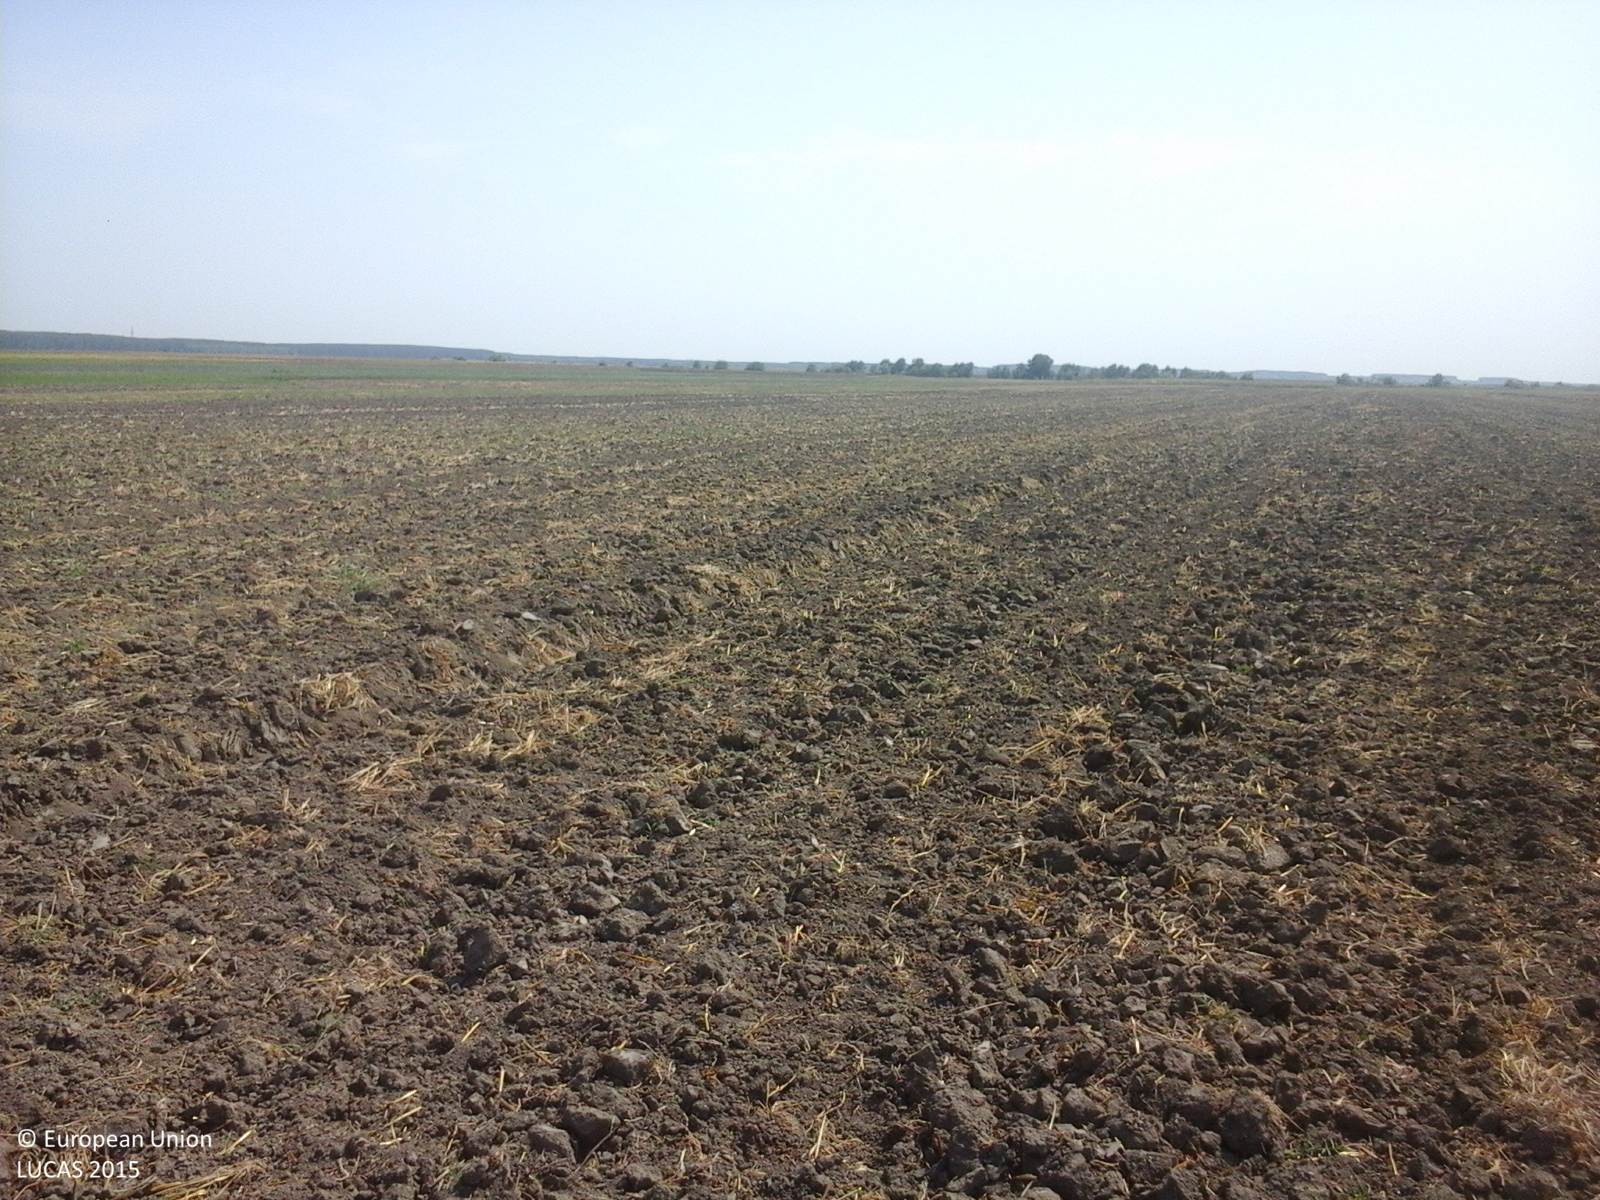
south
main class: Cropland
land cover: Durum wheat
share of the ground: < 10 %
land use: Agriculture (excluding fallow land and kitchen gardens)
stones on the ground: < 10 %
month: August
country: RO
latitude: 44.8162
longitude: 28.0567
